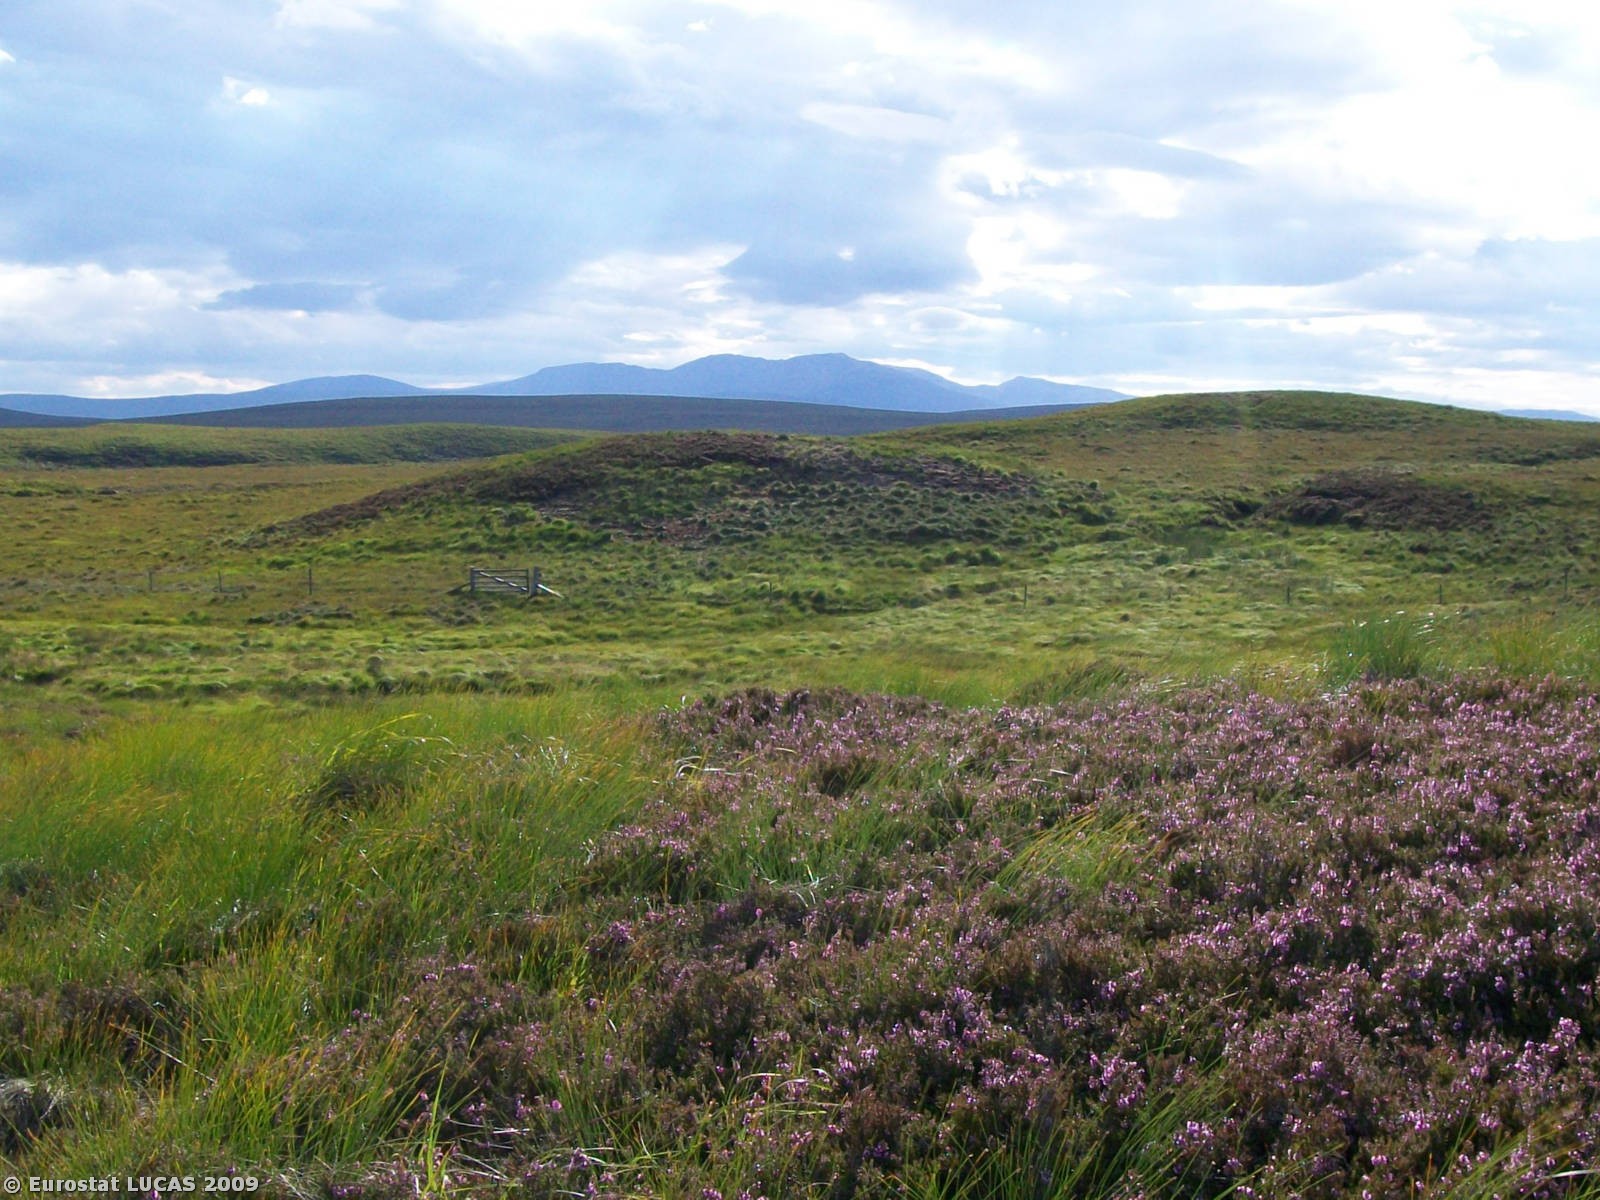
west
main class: Shrubland
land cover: Shrubland without tree cover
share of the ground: > 75 %
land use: Fallow land
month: August
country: GB
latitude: 58.1935
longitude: -4.5301
